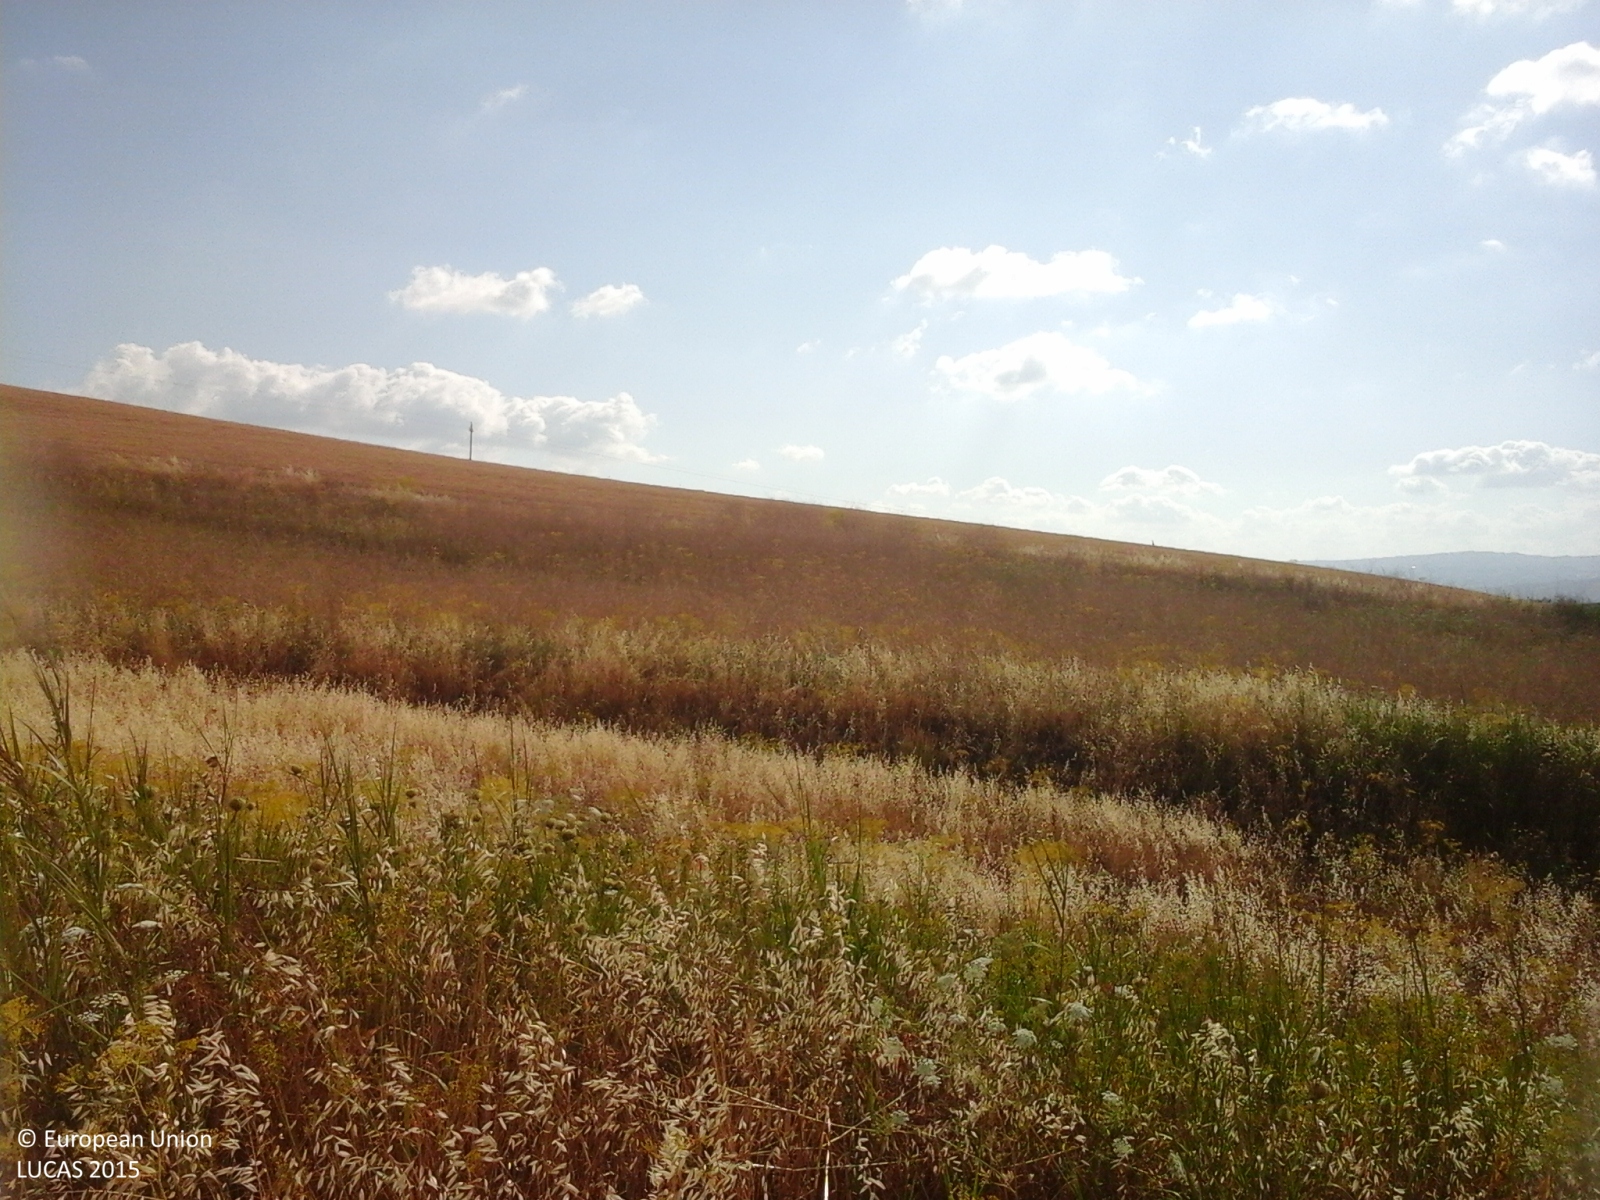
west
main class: Grassland
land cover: Spontaneously vegetated surfaces
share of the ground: > 75 %
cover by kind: herbaceous plants 100 %
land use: Fallow land
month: June
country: IT
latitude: 37.7342
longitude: 13.0748
